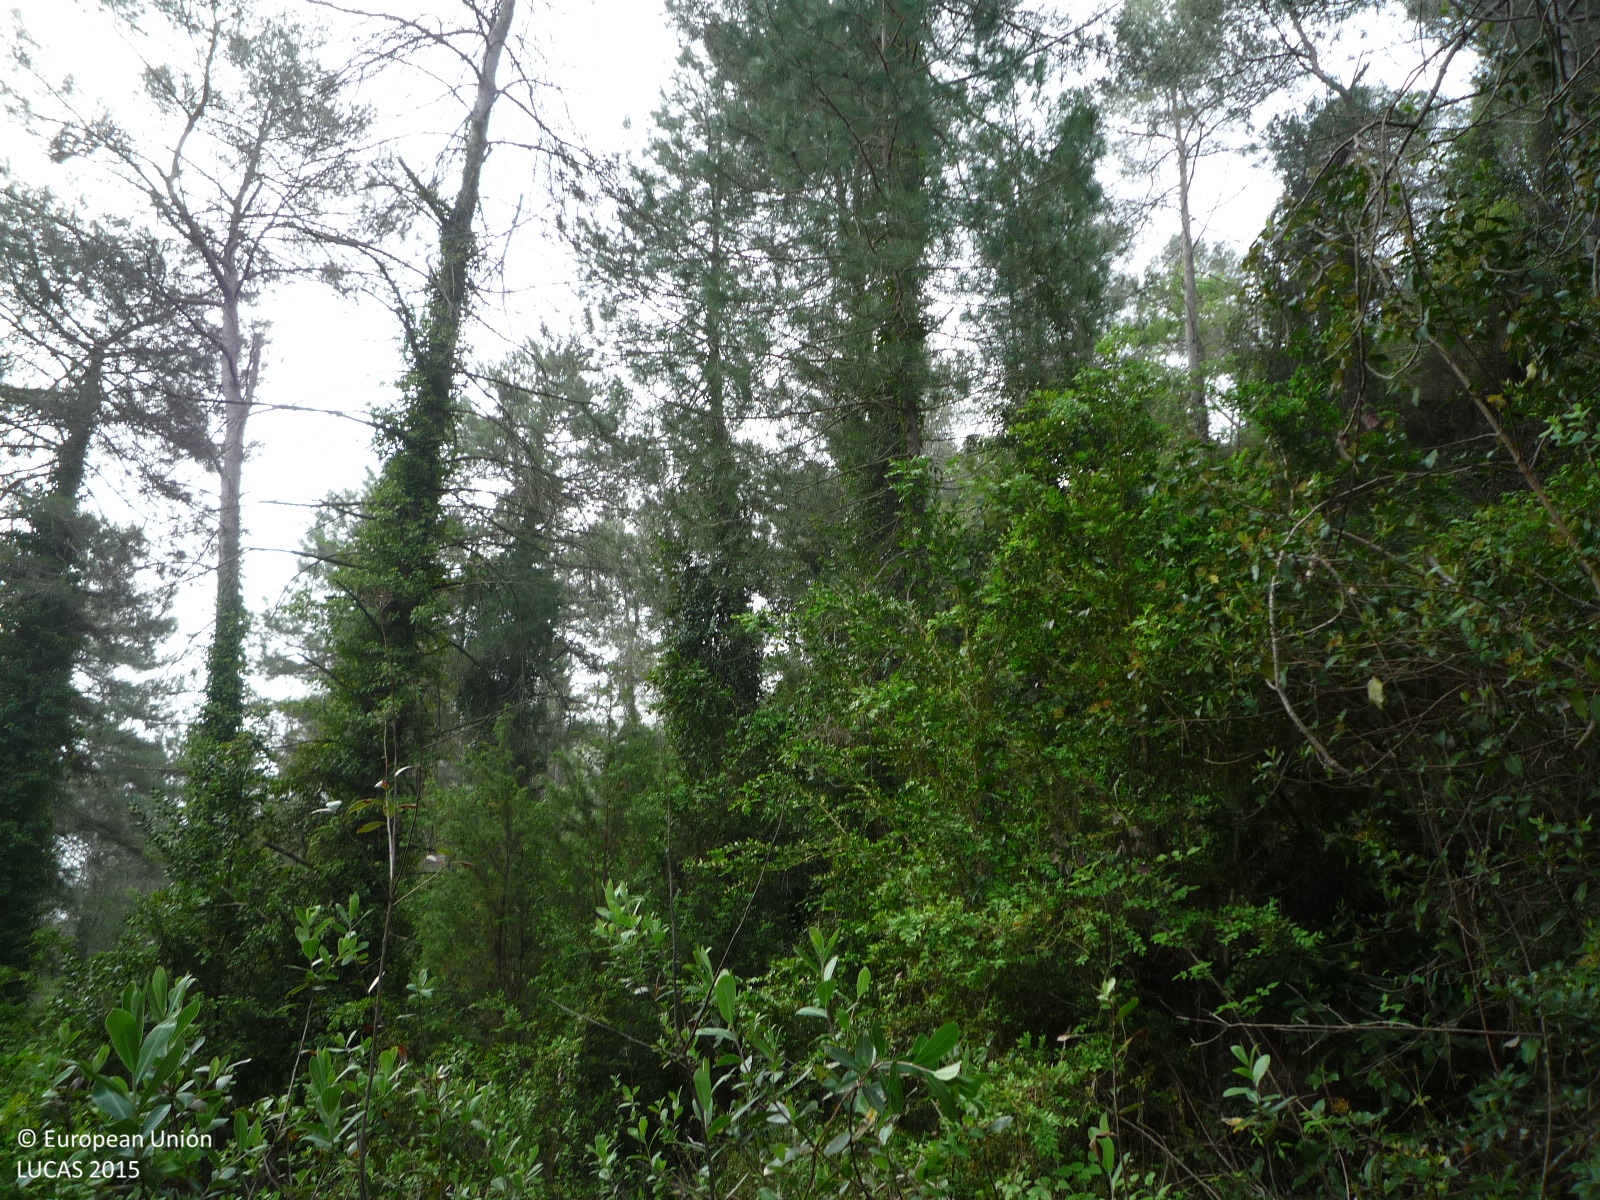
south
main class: Woodland
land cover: Pine dominated mixed woodland
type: coniferous forest of the mediterranean region
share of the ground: > 75 %
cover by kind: coniferous forest trees 60 %, broadleaved forest trees 40 %
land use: Semi-natural and natural areas not in use
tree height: > 5 m
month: April
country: ES
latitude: 41.6768
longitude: 1.6907
